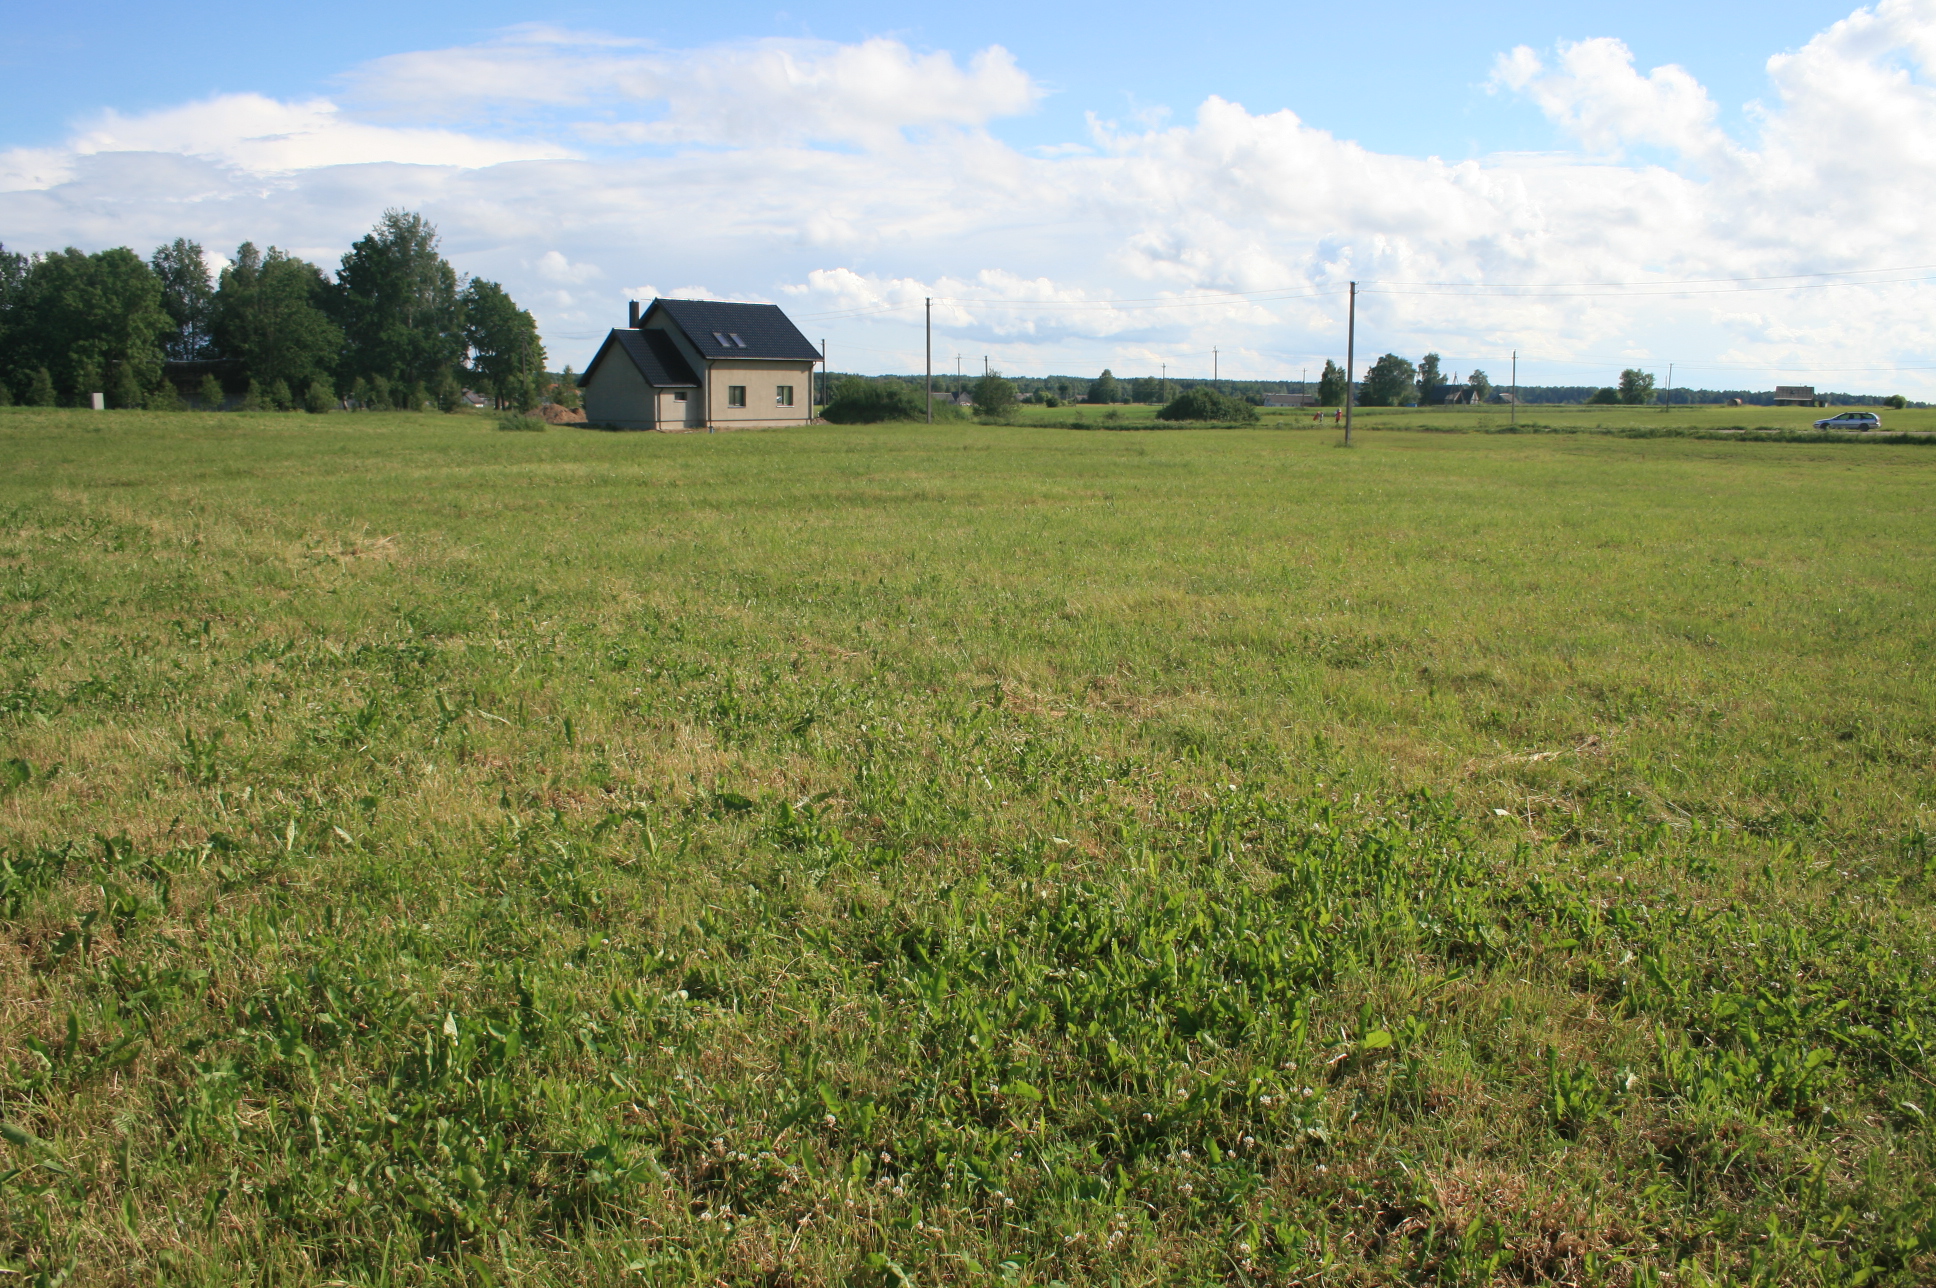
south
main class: Grassland
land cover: Grassland without tree/shrub cover
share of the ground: > 75 %
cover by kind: herbaceous plants 100 %
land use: Agriculture (excluding fallow land and kitchen gardens)
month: June
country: LT
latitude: 55.4971
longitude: 22.1652
